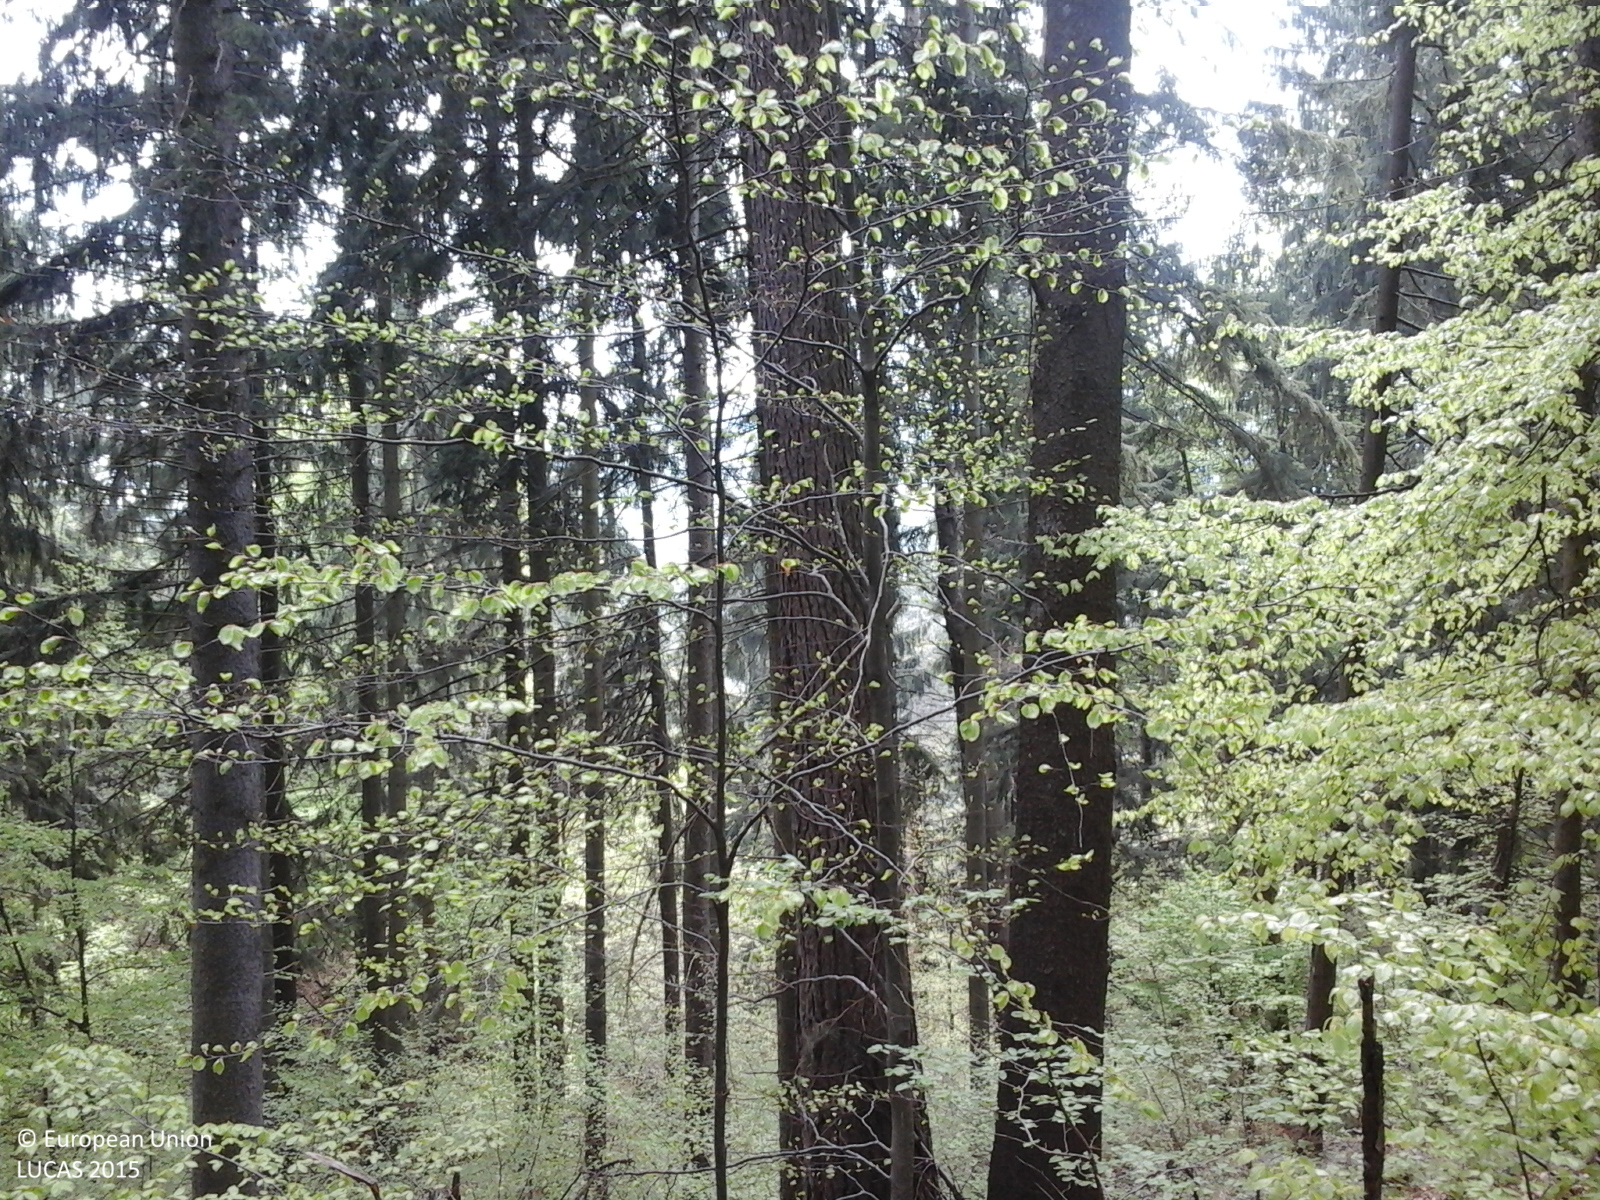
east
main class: Woodland
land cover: Other mixed woodland
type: beech forest
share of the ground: > 75 %
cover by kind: broadleaved forest trees 75 %, coniferous forest trees 25 %
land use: Forestry
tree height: > 5 m
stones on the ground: < 10 %
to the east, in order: Other mixed woodland; Rocks and stones; Other mixed woodland
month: May
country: RO
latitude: 45.6255
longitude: 25.5588
